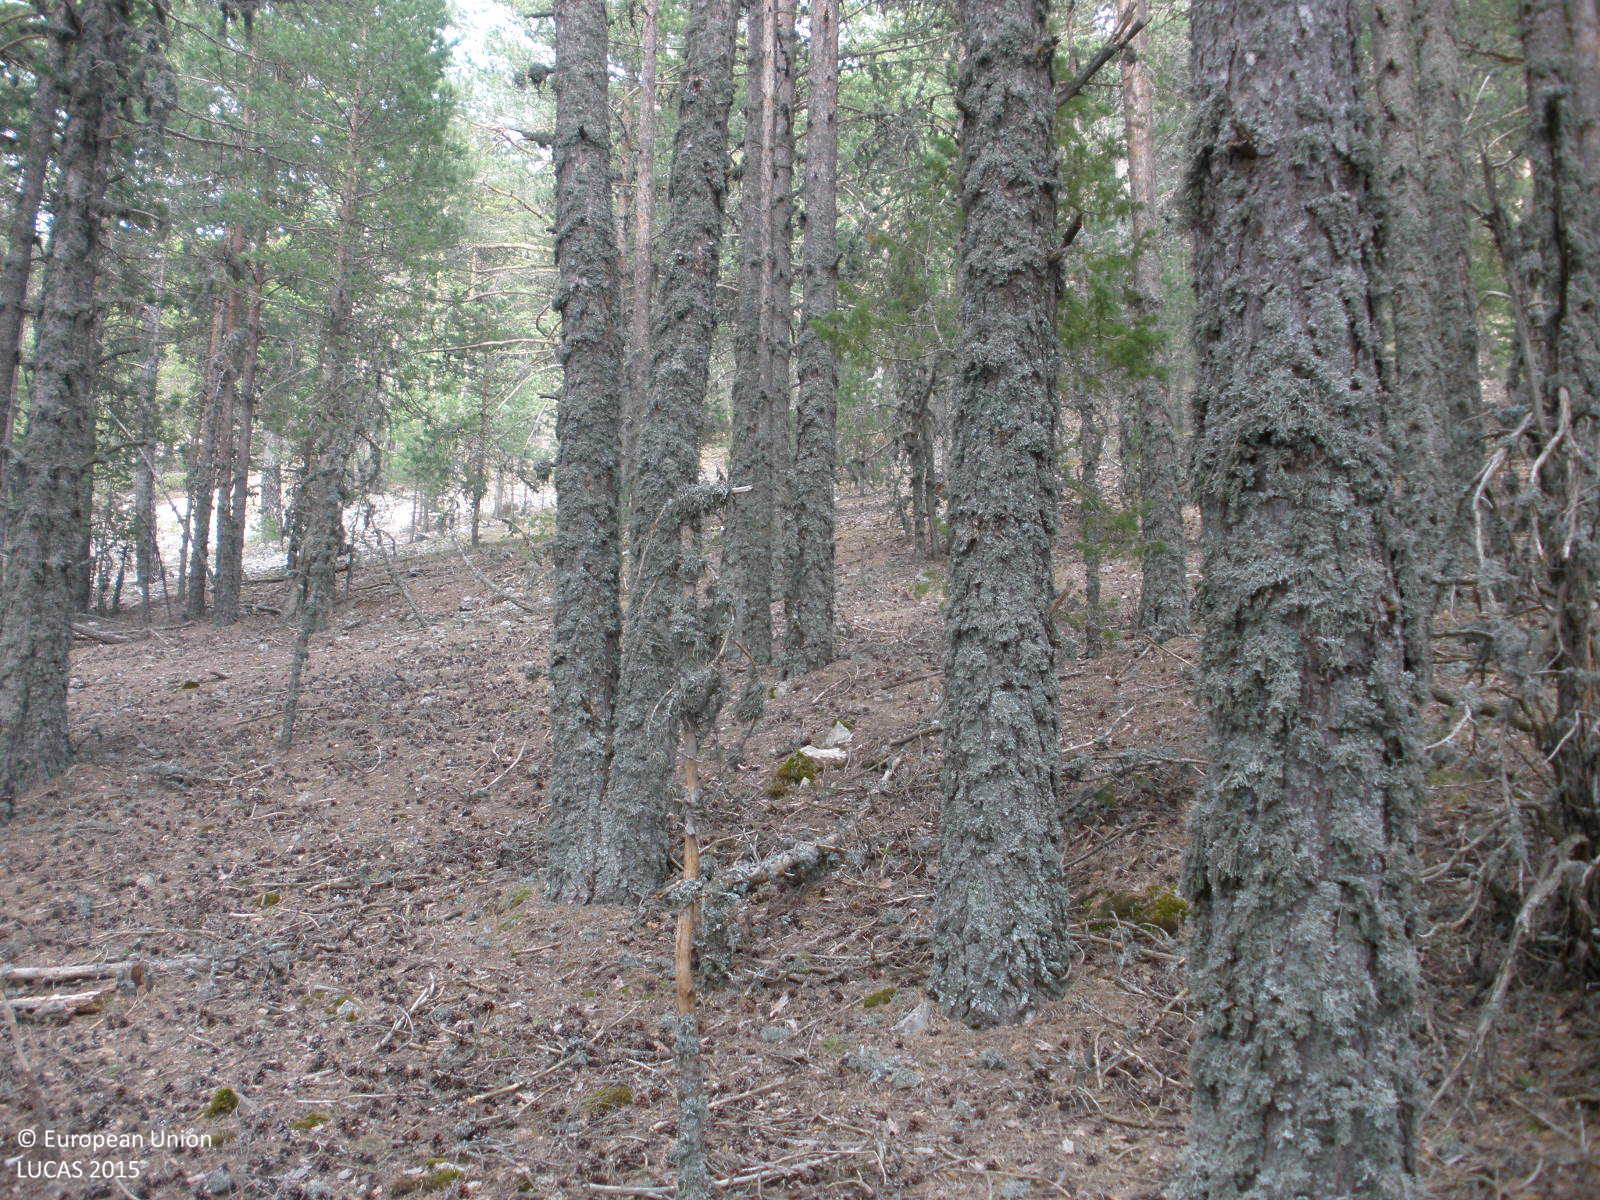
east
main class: Woodland
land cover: Pine dominated coniferous woodland
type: coniferous forest of the mediterranean region
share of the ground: > 75 %
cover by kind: coniferous forest trees 90 %, consolidated bare surface 10 %
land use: Semi-natural and natural areas not in use
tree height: > 5 m
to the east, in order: Pine dominated coniferous woodland
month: April
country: ES
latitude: 40.1183
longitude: -1.0255
